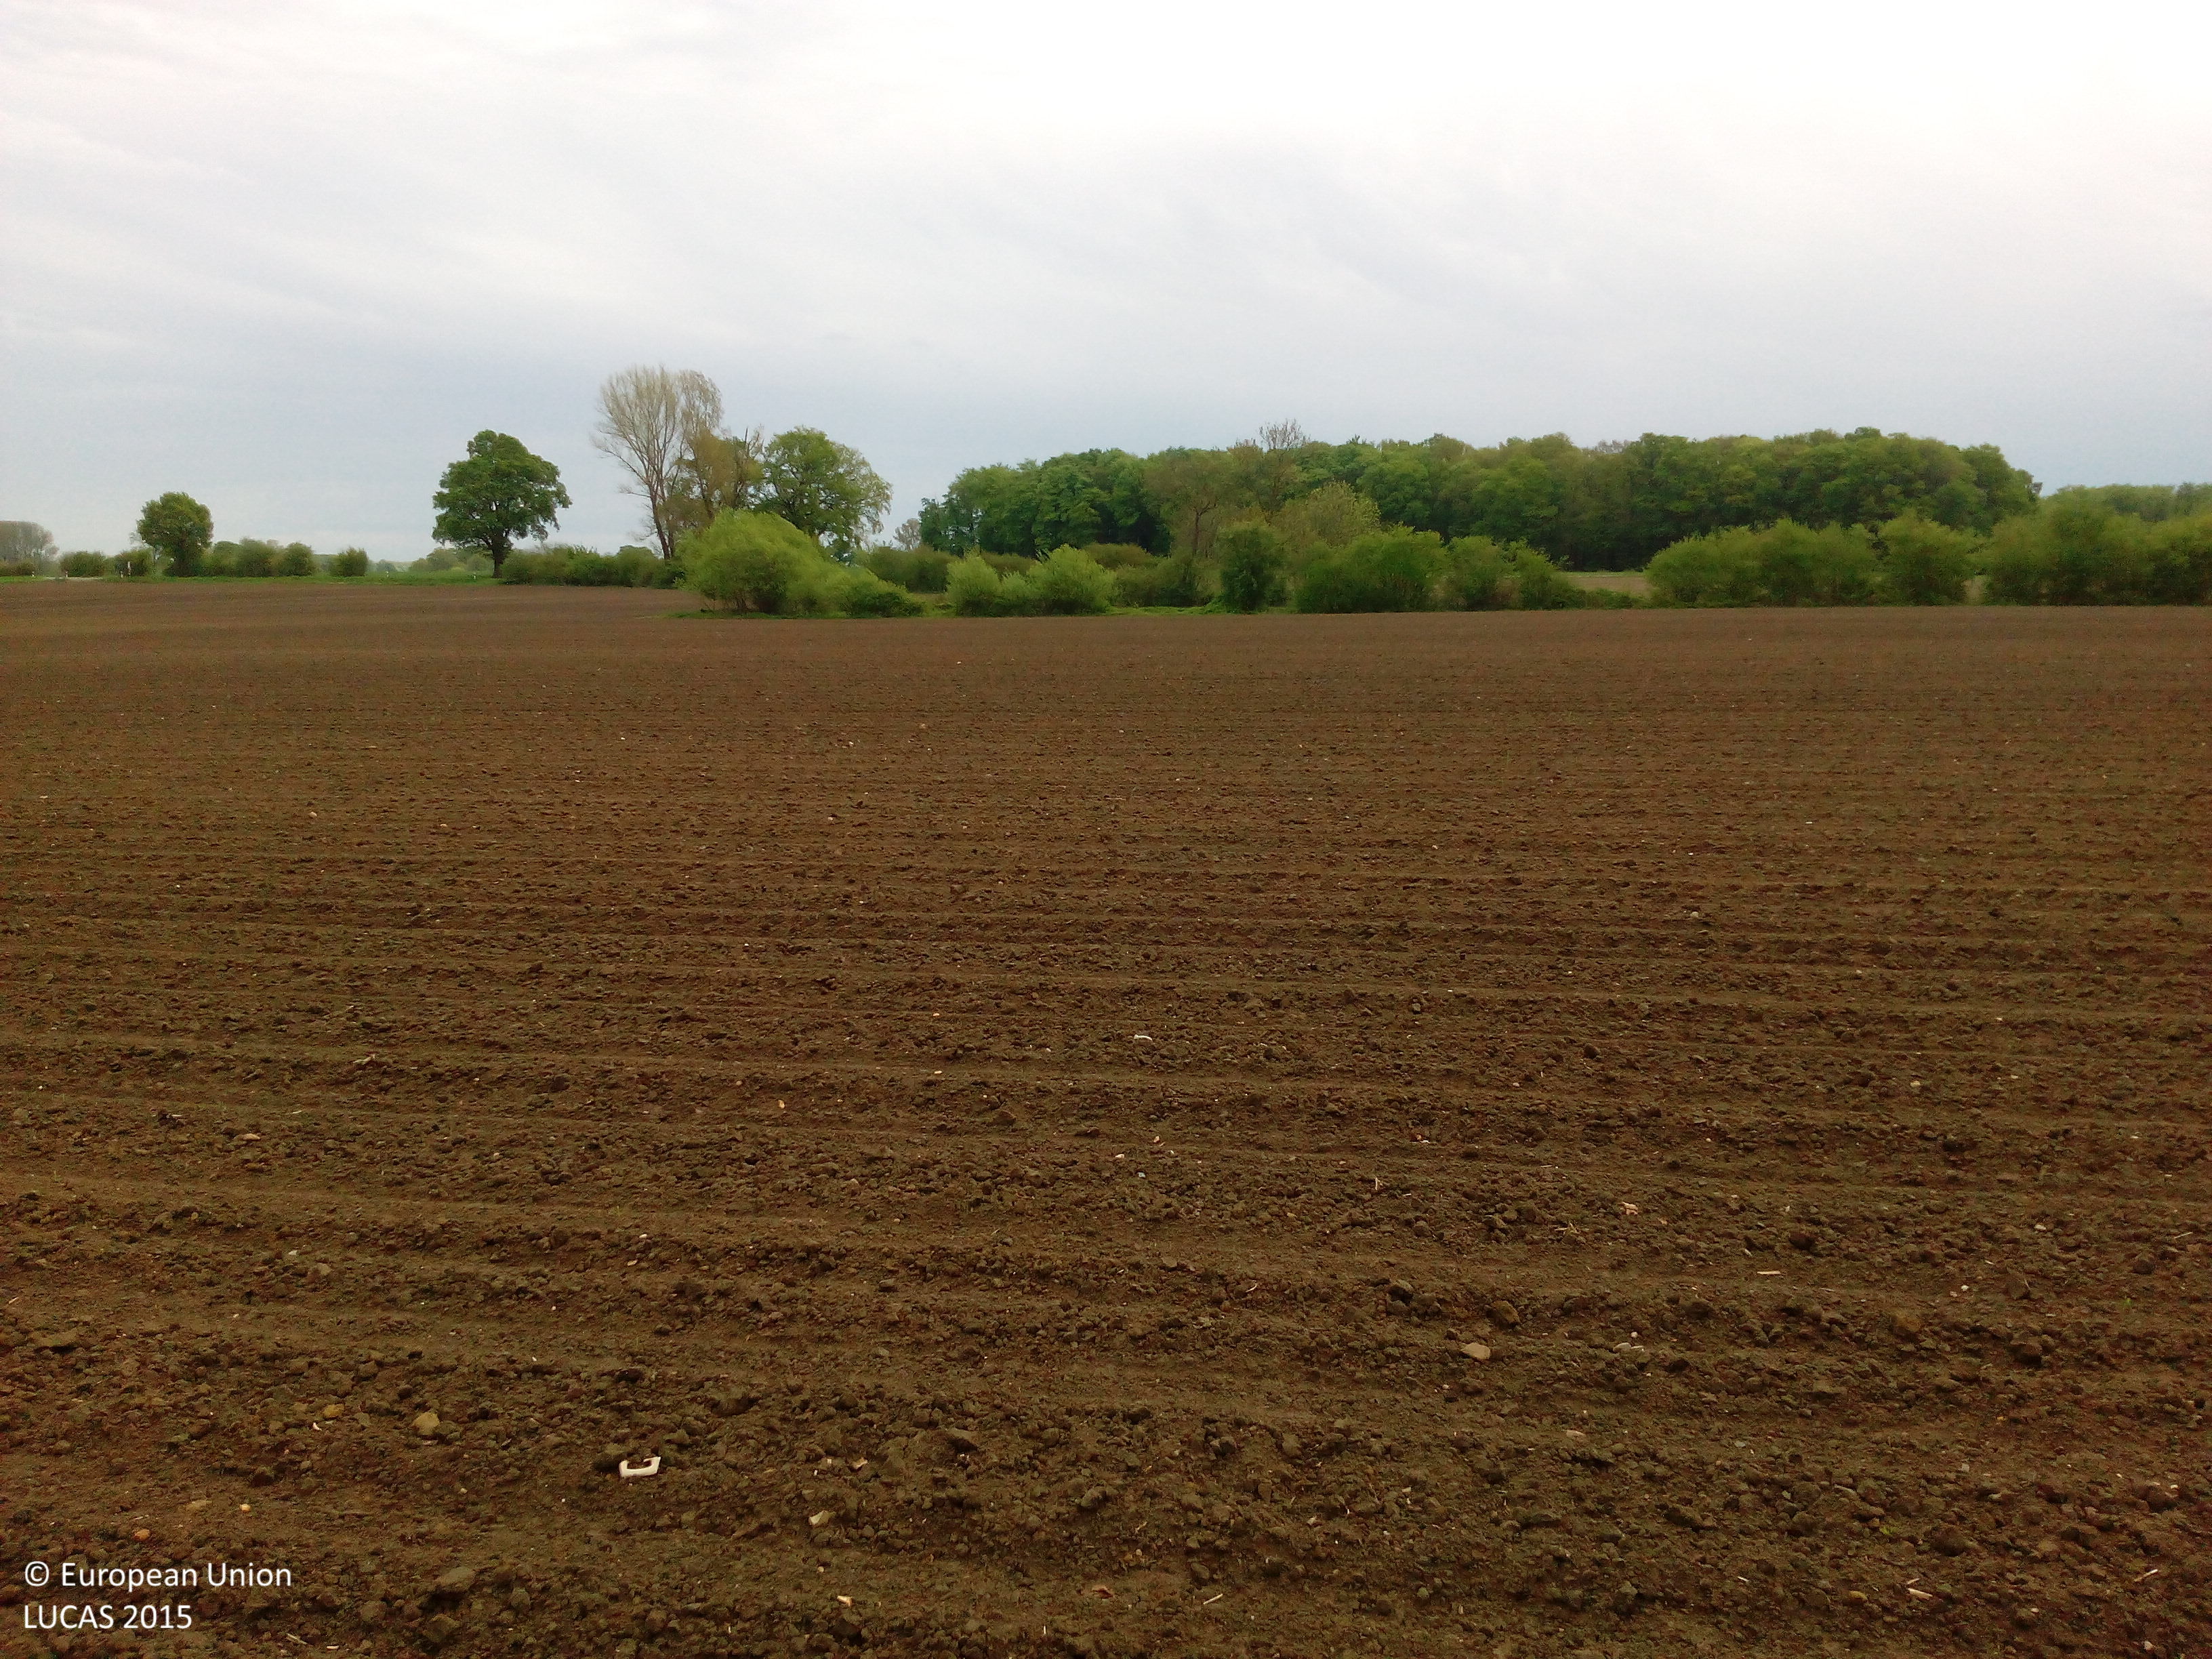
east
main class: Cropland
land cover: Maize
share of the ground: < 10 %
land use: Agriculture (excluding fallow land and kitchen gardens)
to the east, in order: Maize; Ditches and canals; Abandoned hedges; Maize; Ditches and canals; Abandoned hedges; Maize; Abandoned hedges; Ditches and canals; Maize; Grass margins; Paved roads, cycling and walking lanes
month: May
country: DE
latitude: 51.8288
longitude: 7.4610
